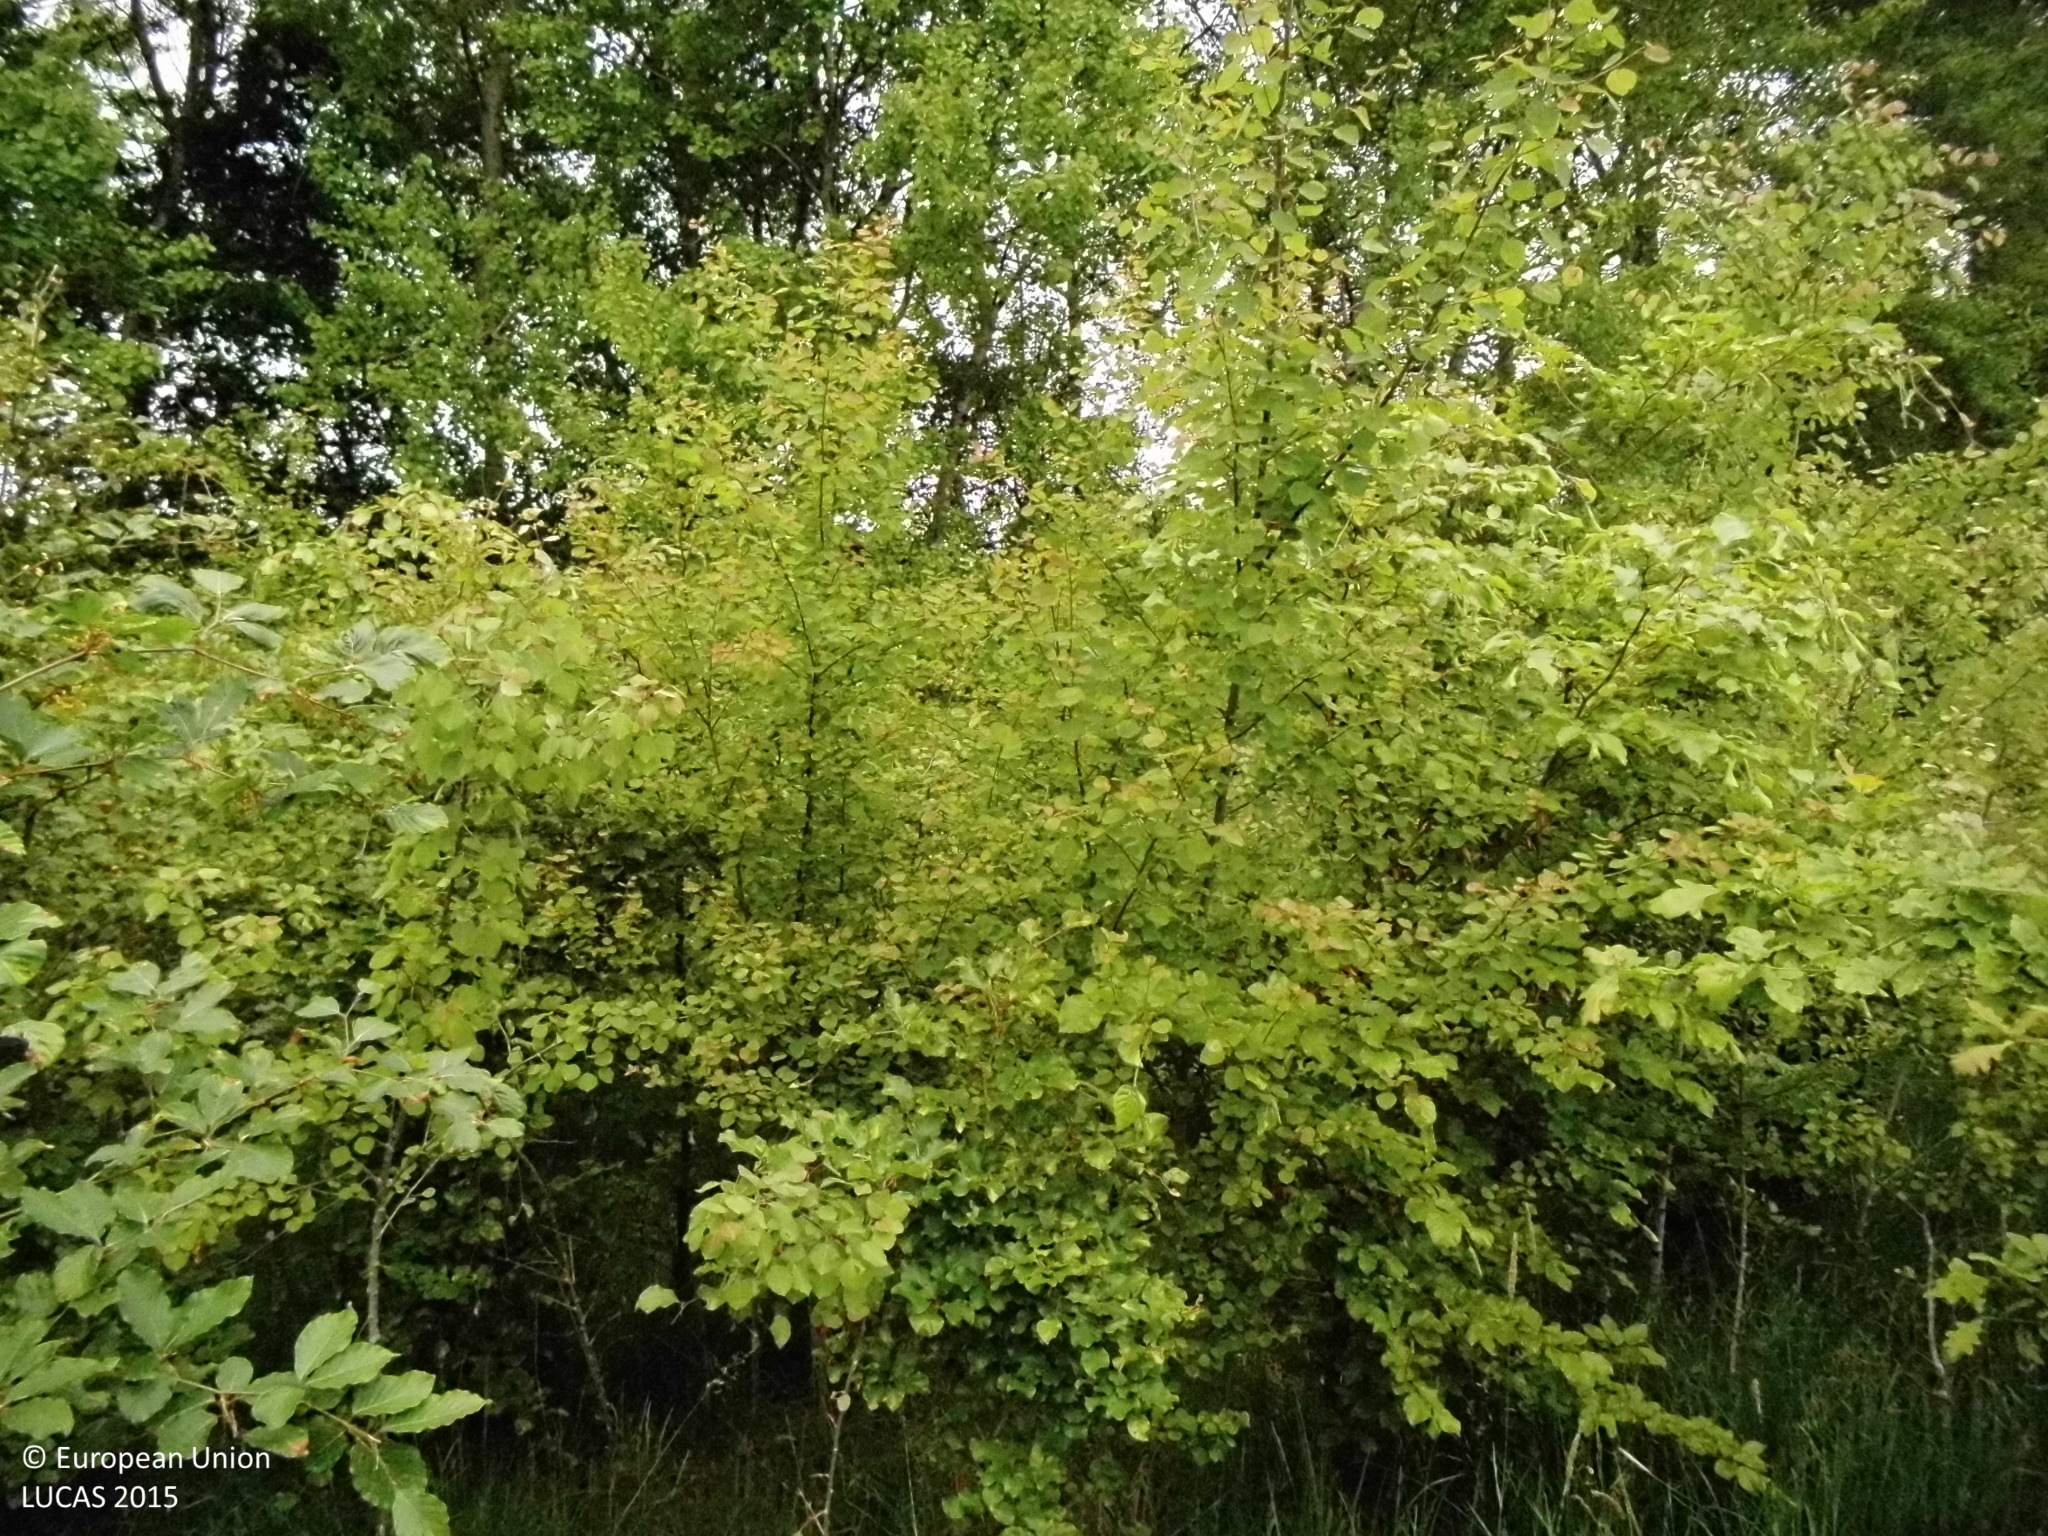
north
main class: Woodland
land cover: Broadleaved woodland
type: mesophytic deciduous forest
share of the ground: 50 - 75 %
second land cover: Grassland without tree/shrub cover
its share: > 75 %
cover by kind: broadleaved forest trees 65 %, herbaceous plants 35 %
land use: Forestry
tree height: < 5 m
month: May
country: DE
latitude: 50.8947
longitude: 7.5122
